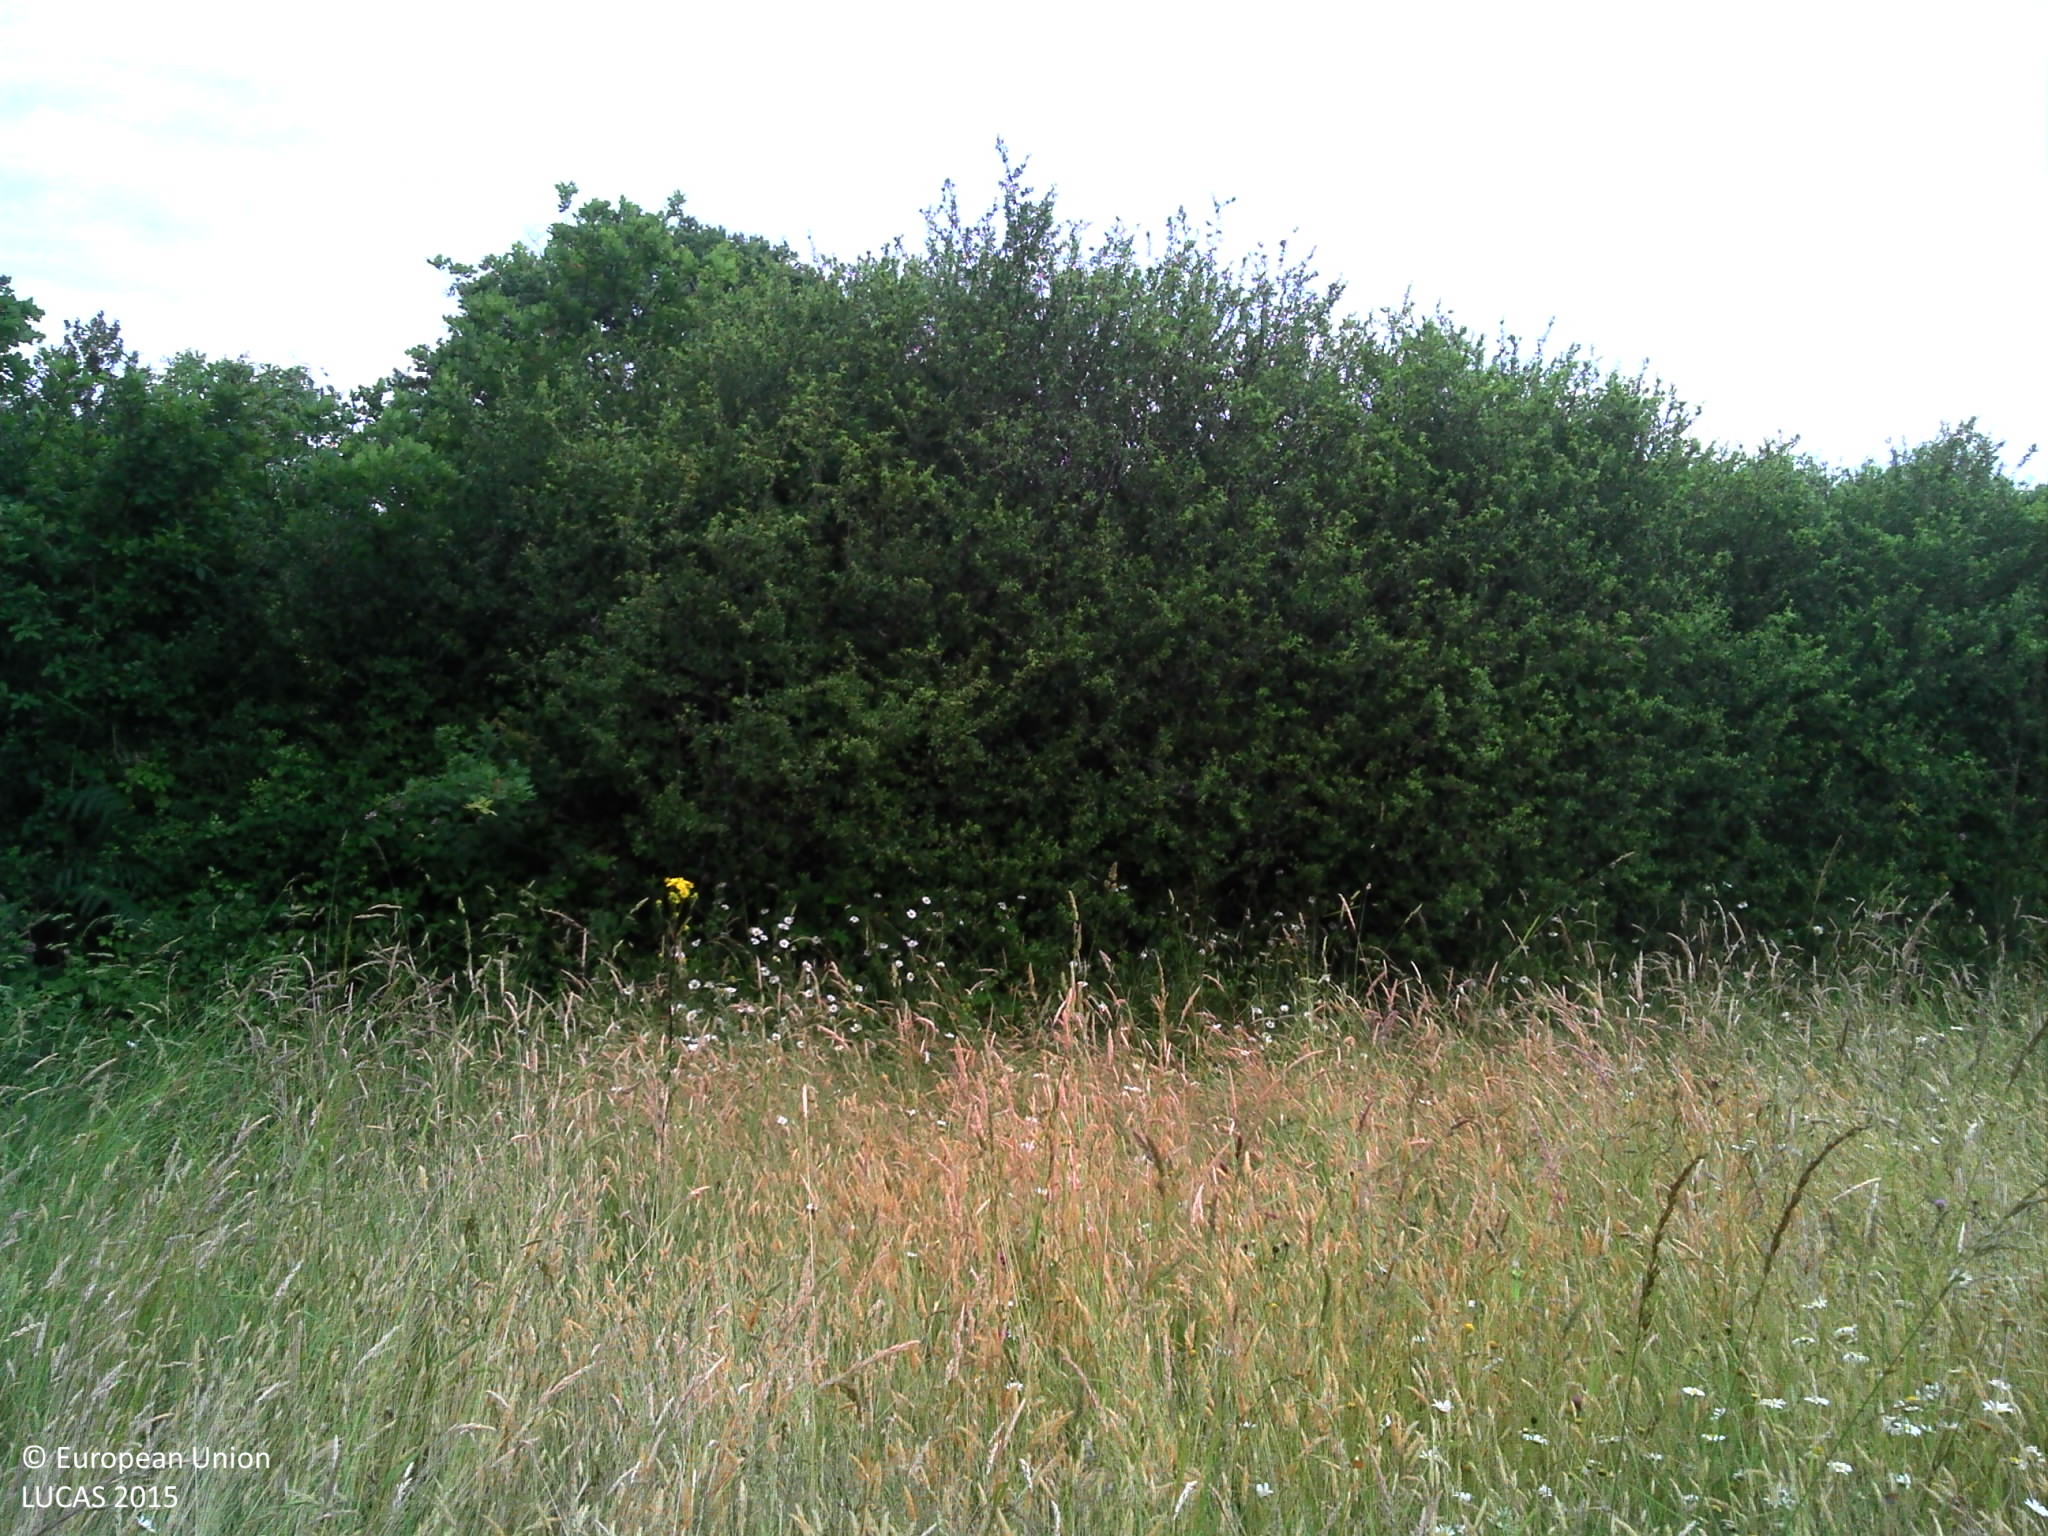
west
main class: Grassland
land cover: Grassland without tree/shrub cover
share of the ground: > 75 %
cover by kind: herbaceous plants 100 %
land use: Agriculture (excluding fallow land and kitchen gardens)
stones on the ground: < 10 %
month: June
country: FR
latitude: 45.9505
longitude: 0.5548
